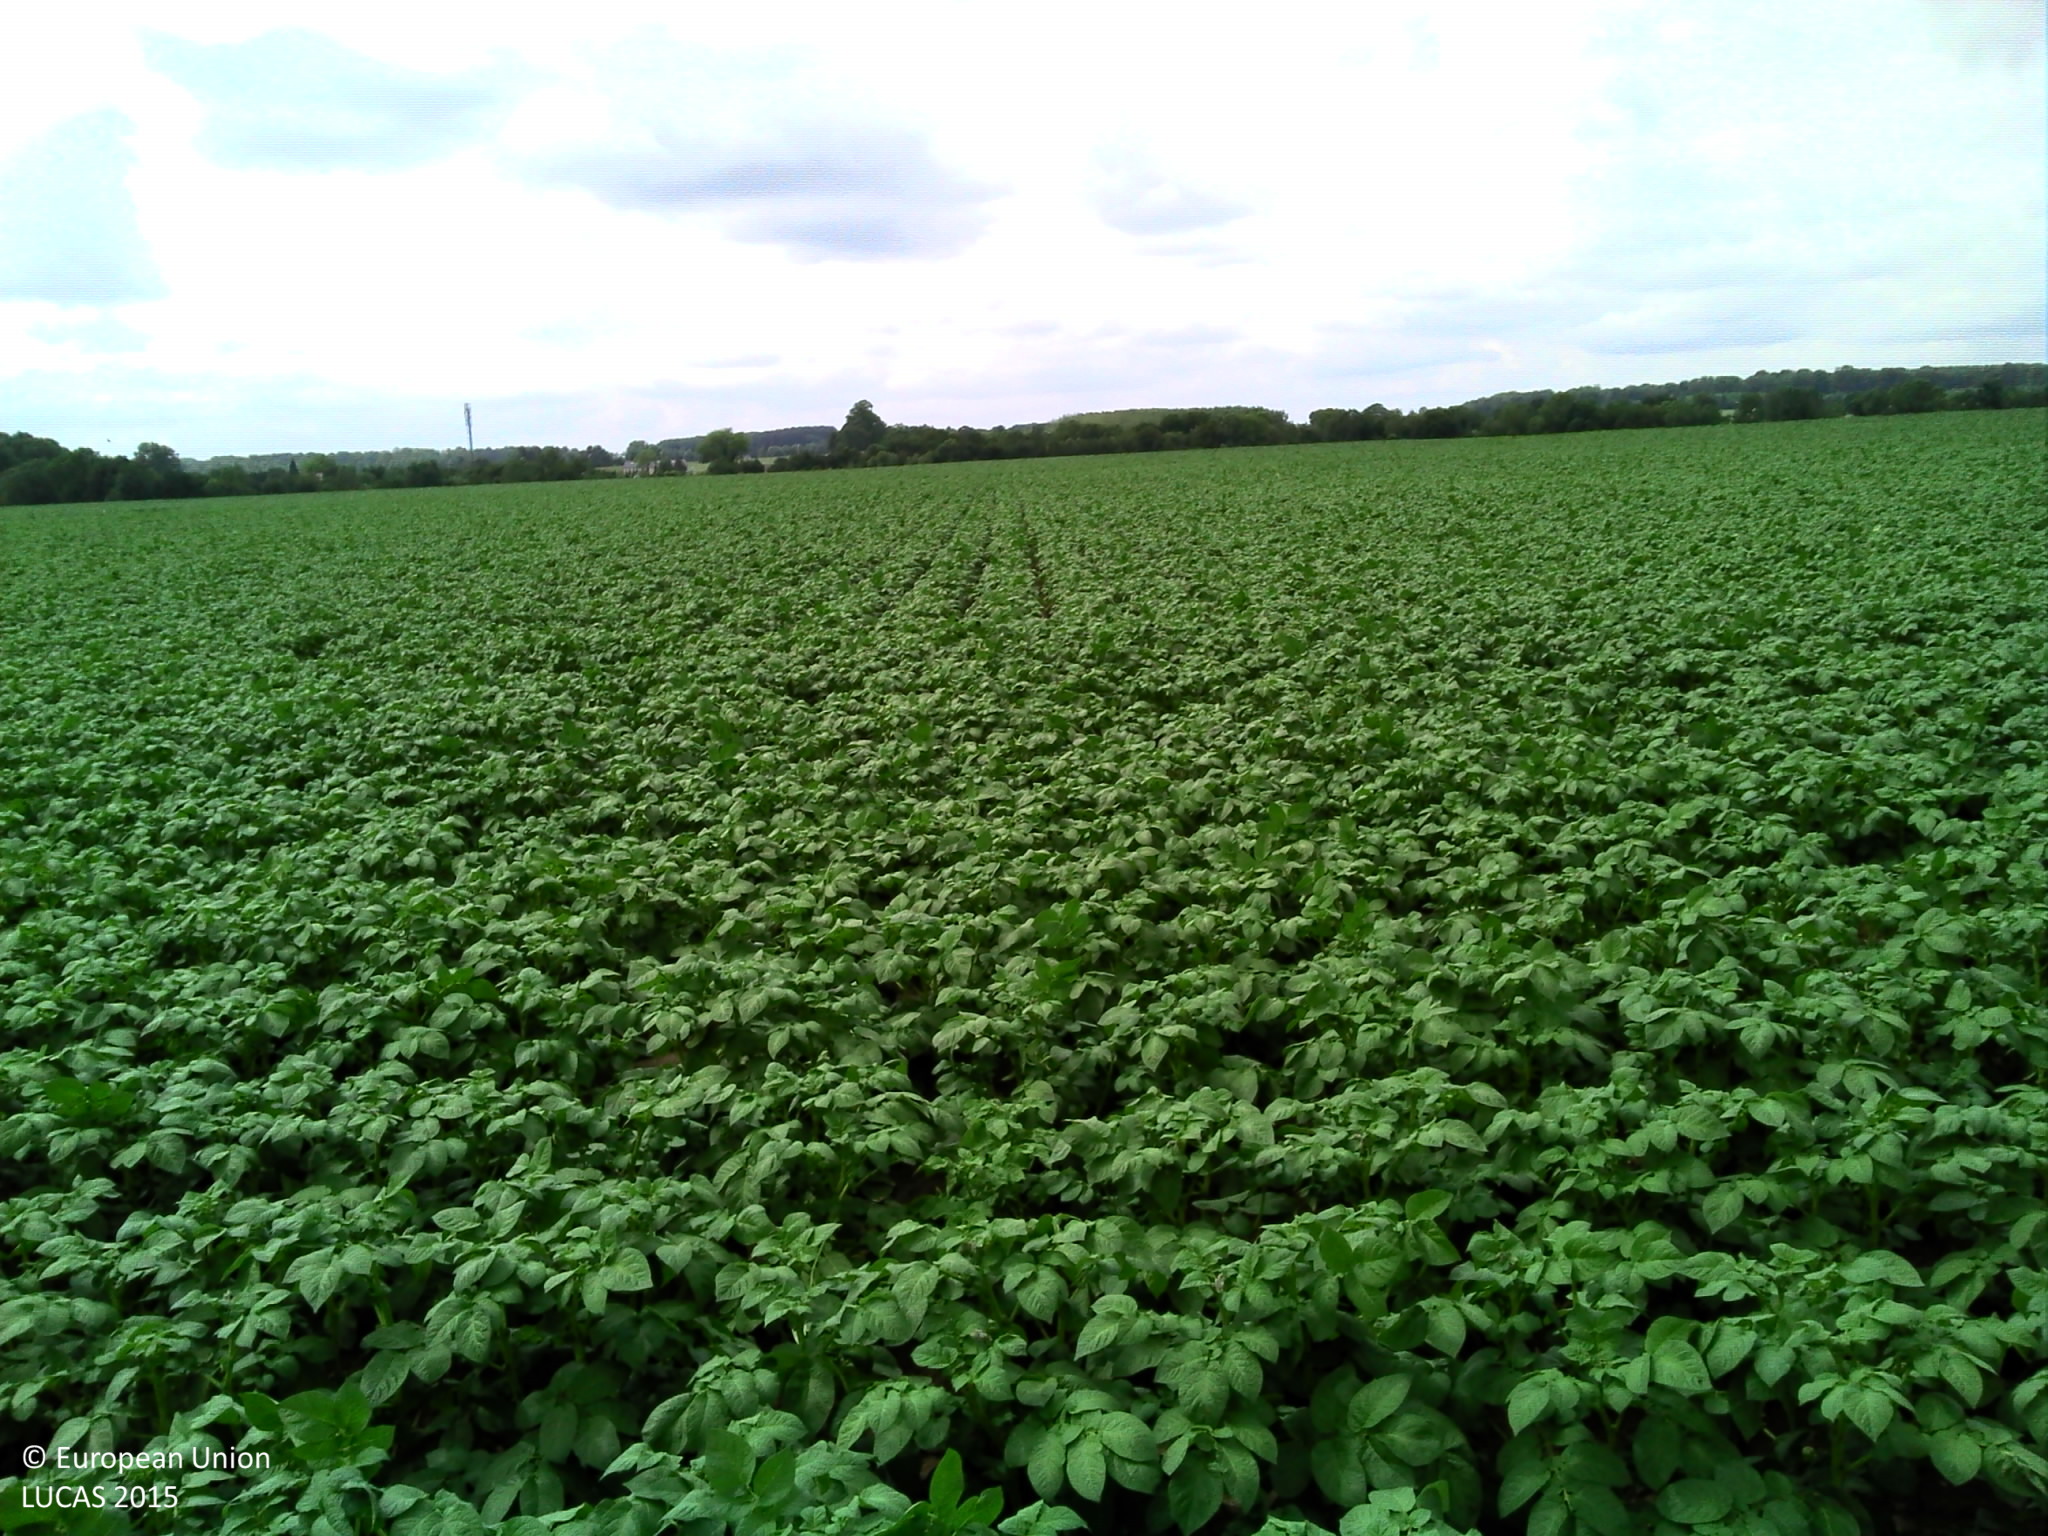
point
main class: Cropland
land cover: Potatoes
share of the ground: > 75 %
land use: Agriculture (excluding fallow land and kitchen gardens)
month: June
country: BE
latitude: 50.5146
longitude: 4.0289
